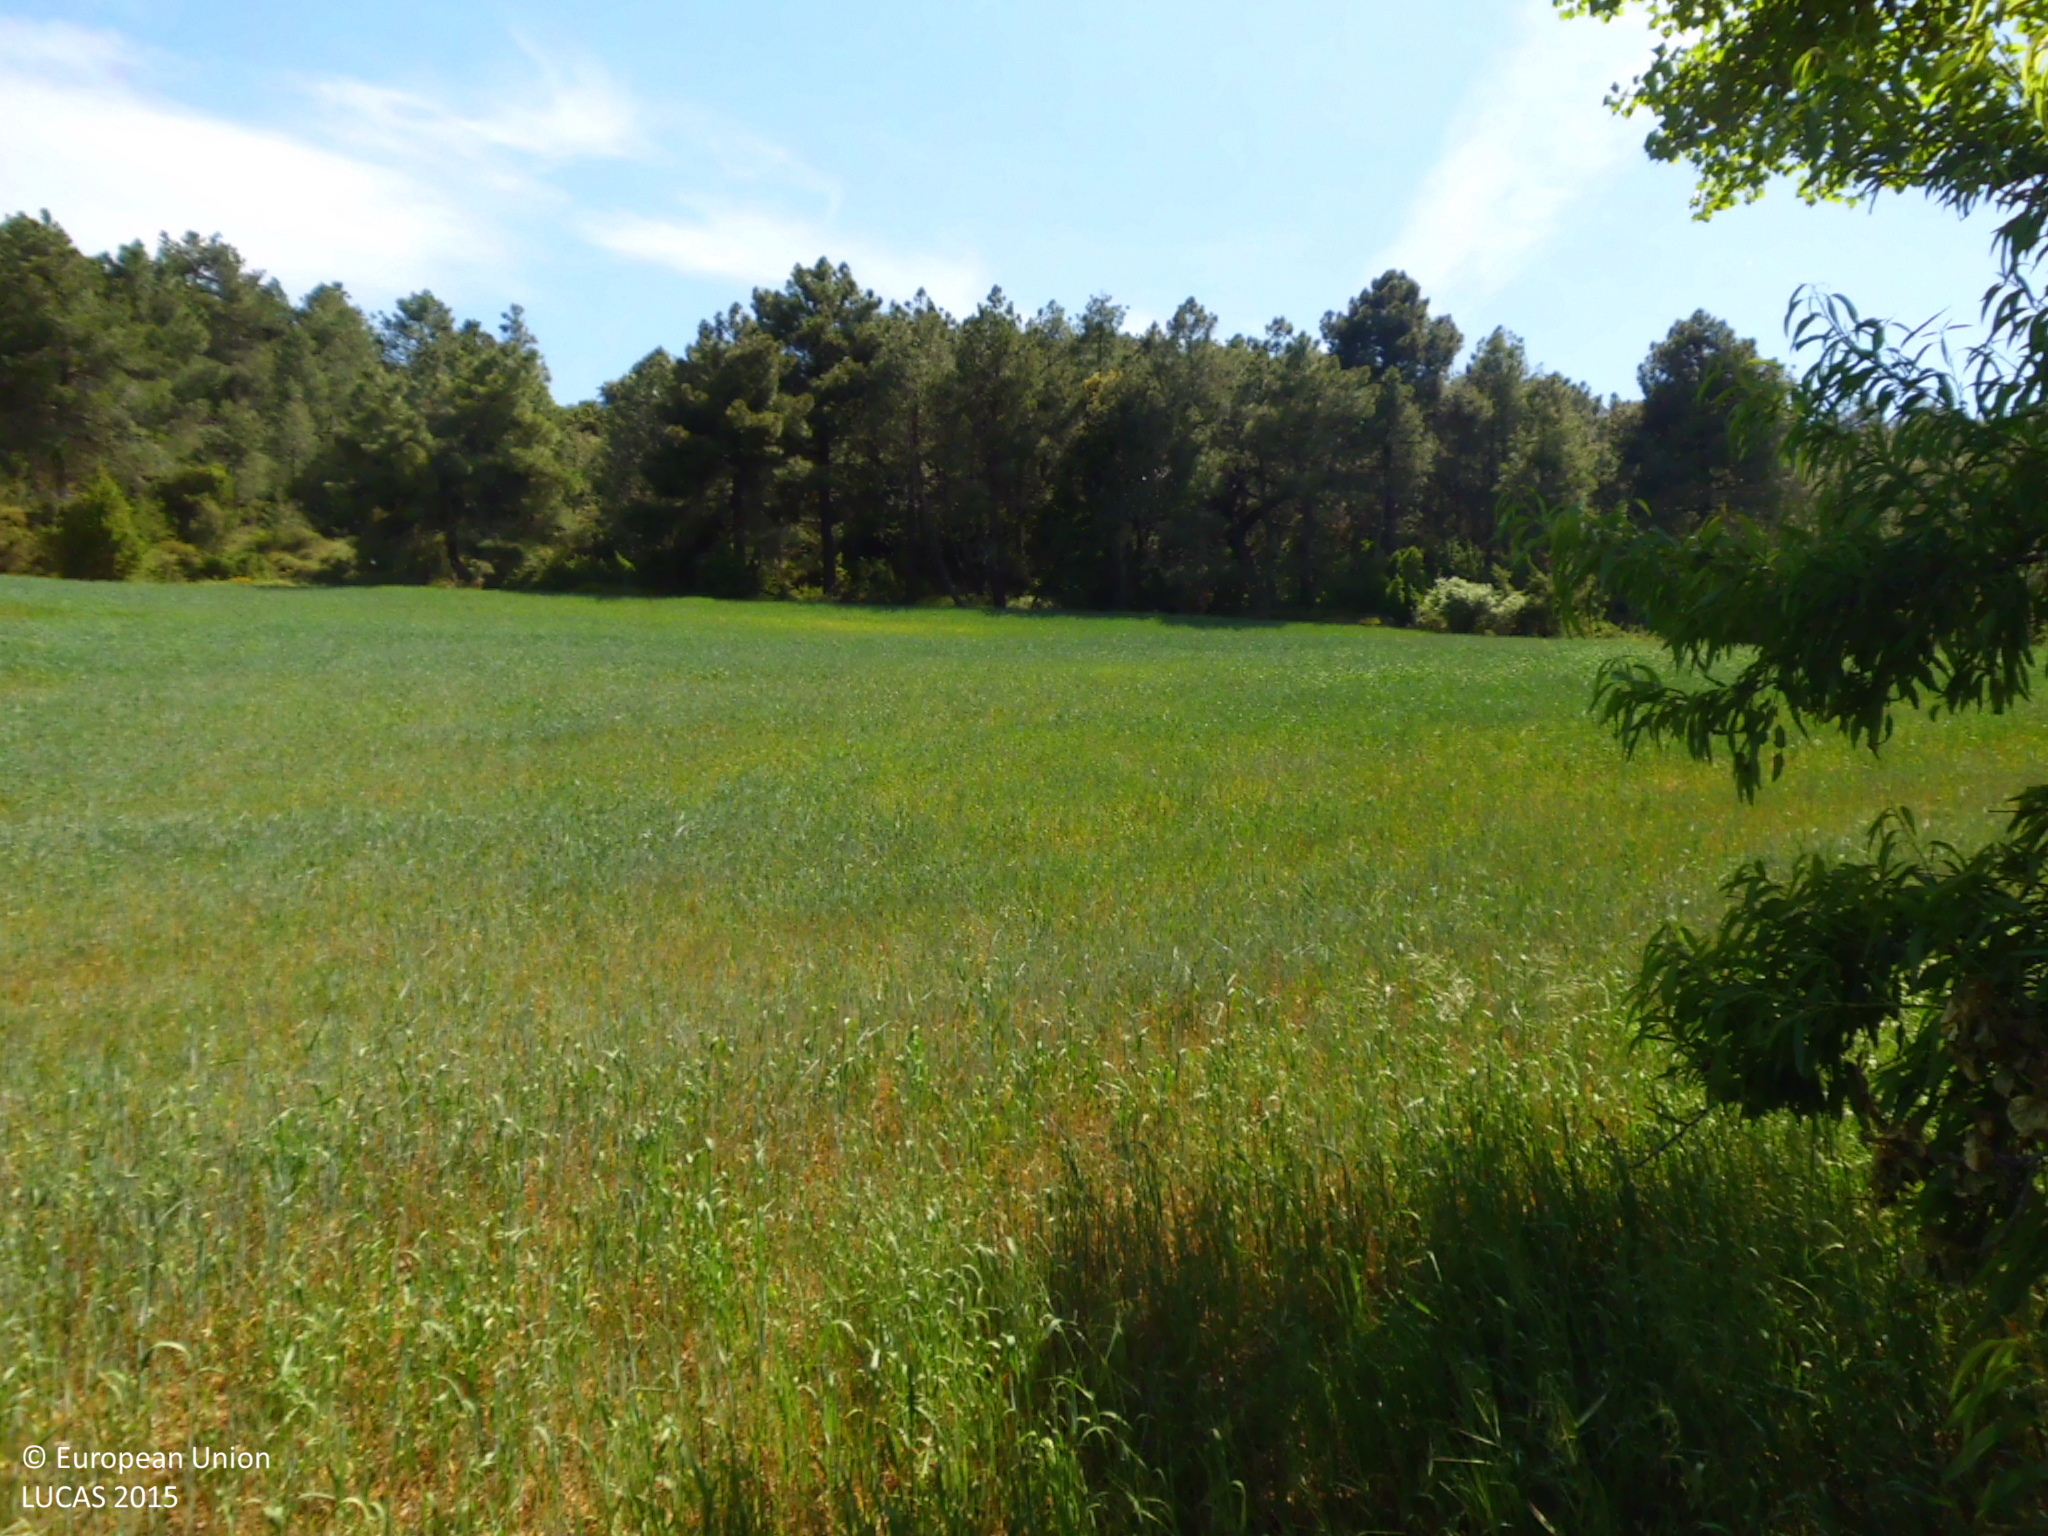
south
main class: Woodland
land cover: Broadleaved woodland
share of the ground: 50 - 75 %
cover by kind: broadleaved forest trees 60 %, shrubs 30 %, herbaceous plants 10 %
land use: Forestry
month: May
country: ES
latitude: 42.6994
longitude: -3.4769
